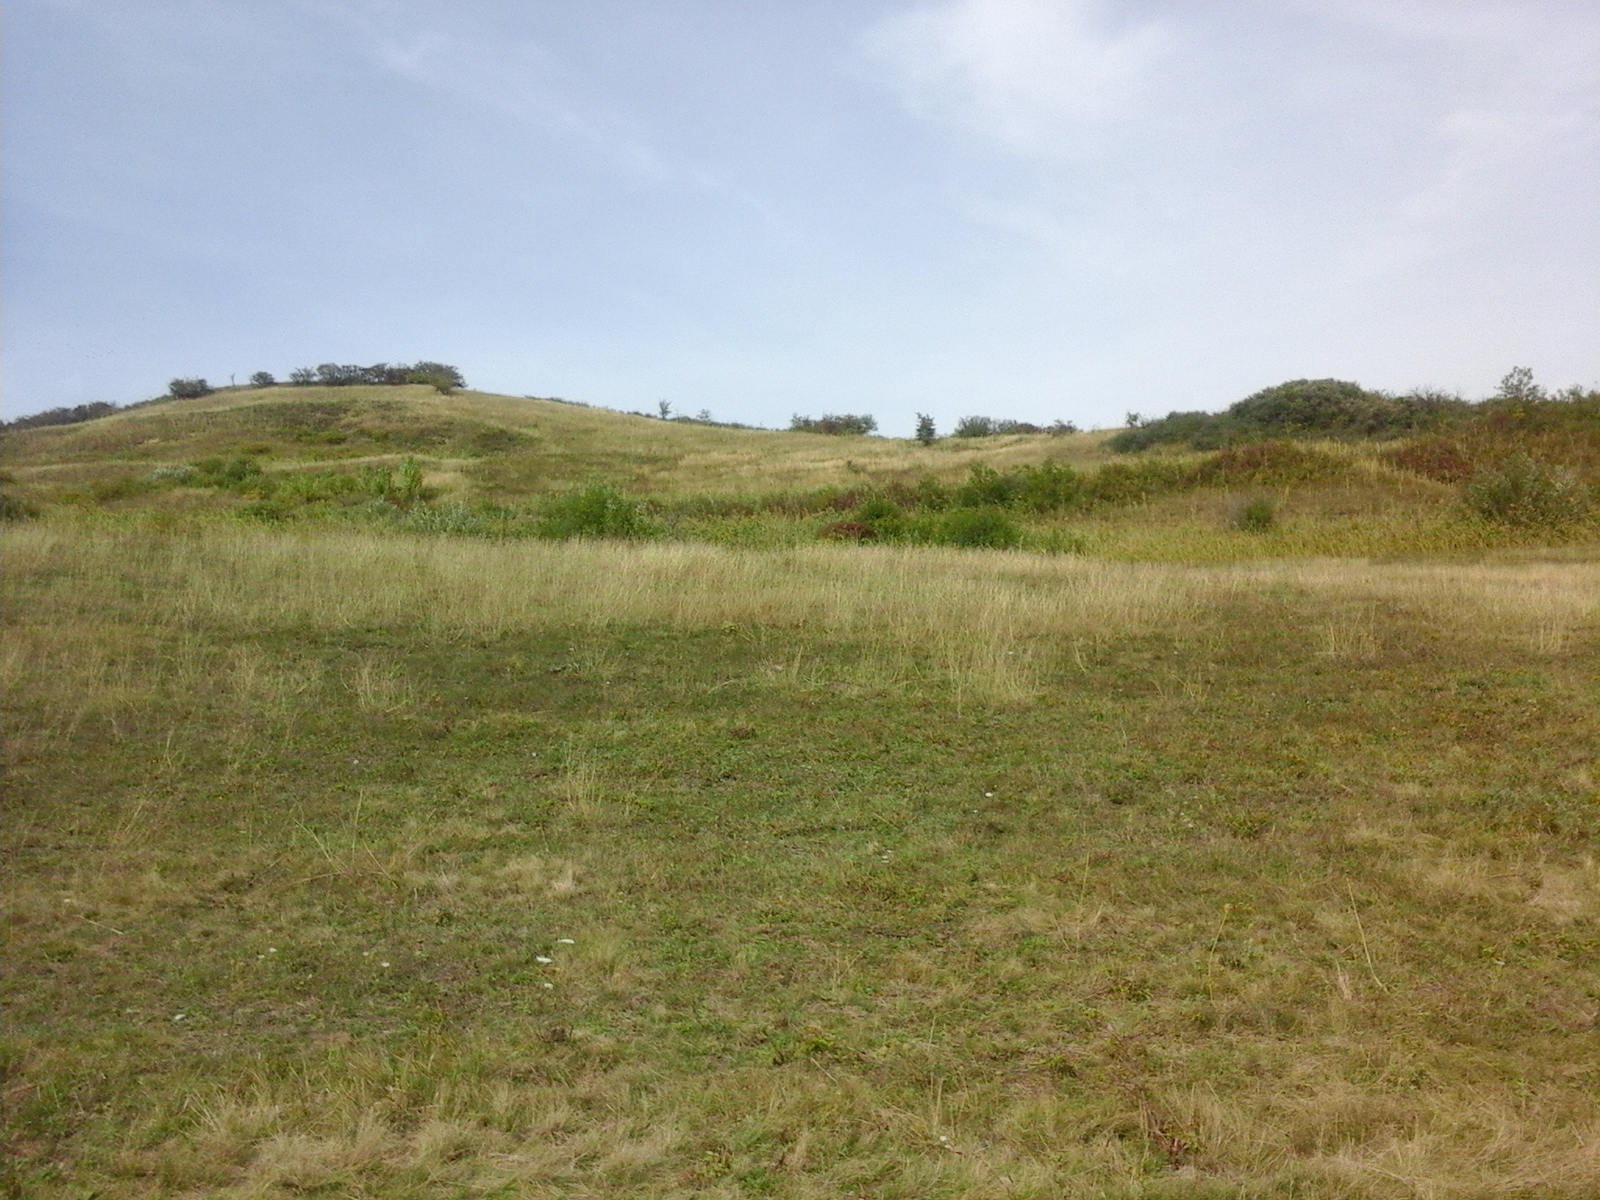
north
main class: Grassland
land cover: Grassland without tree/shrub cover
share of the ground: > 75 %
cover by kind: herbaceous plants 100 %
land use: Agriculture (excluding fallow land and kitchen gardens)
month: September
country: RO
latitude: 46.9144
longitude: 24.0645
